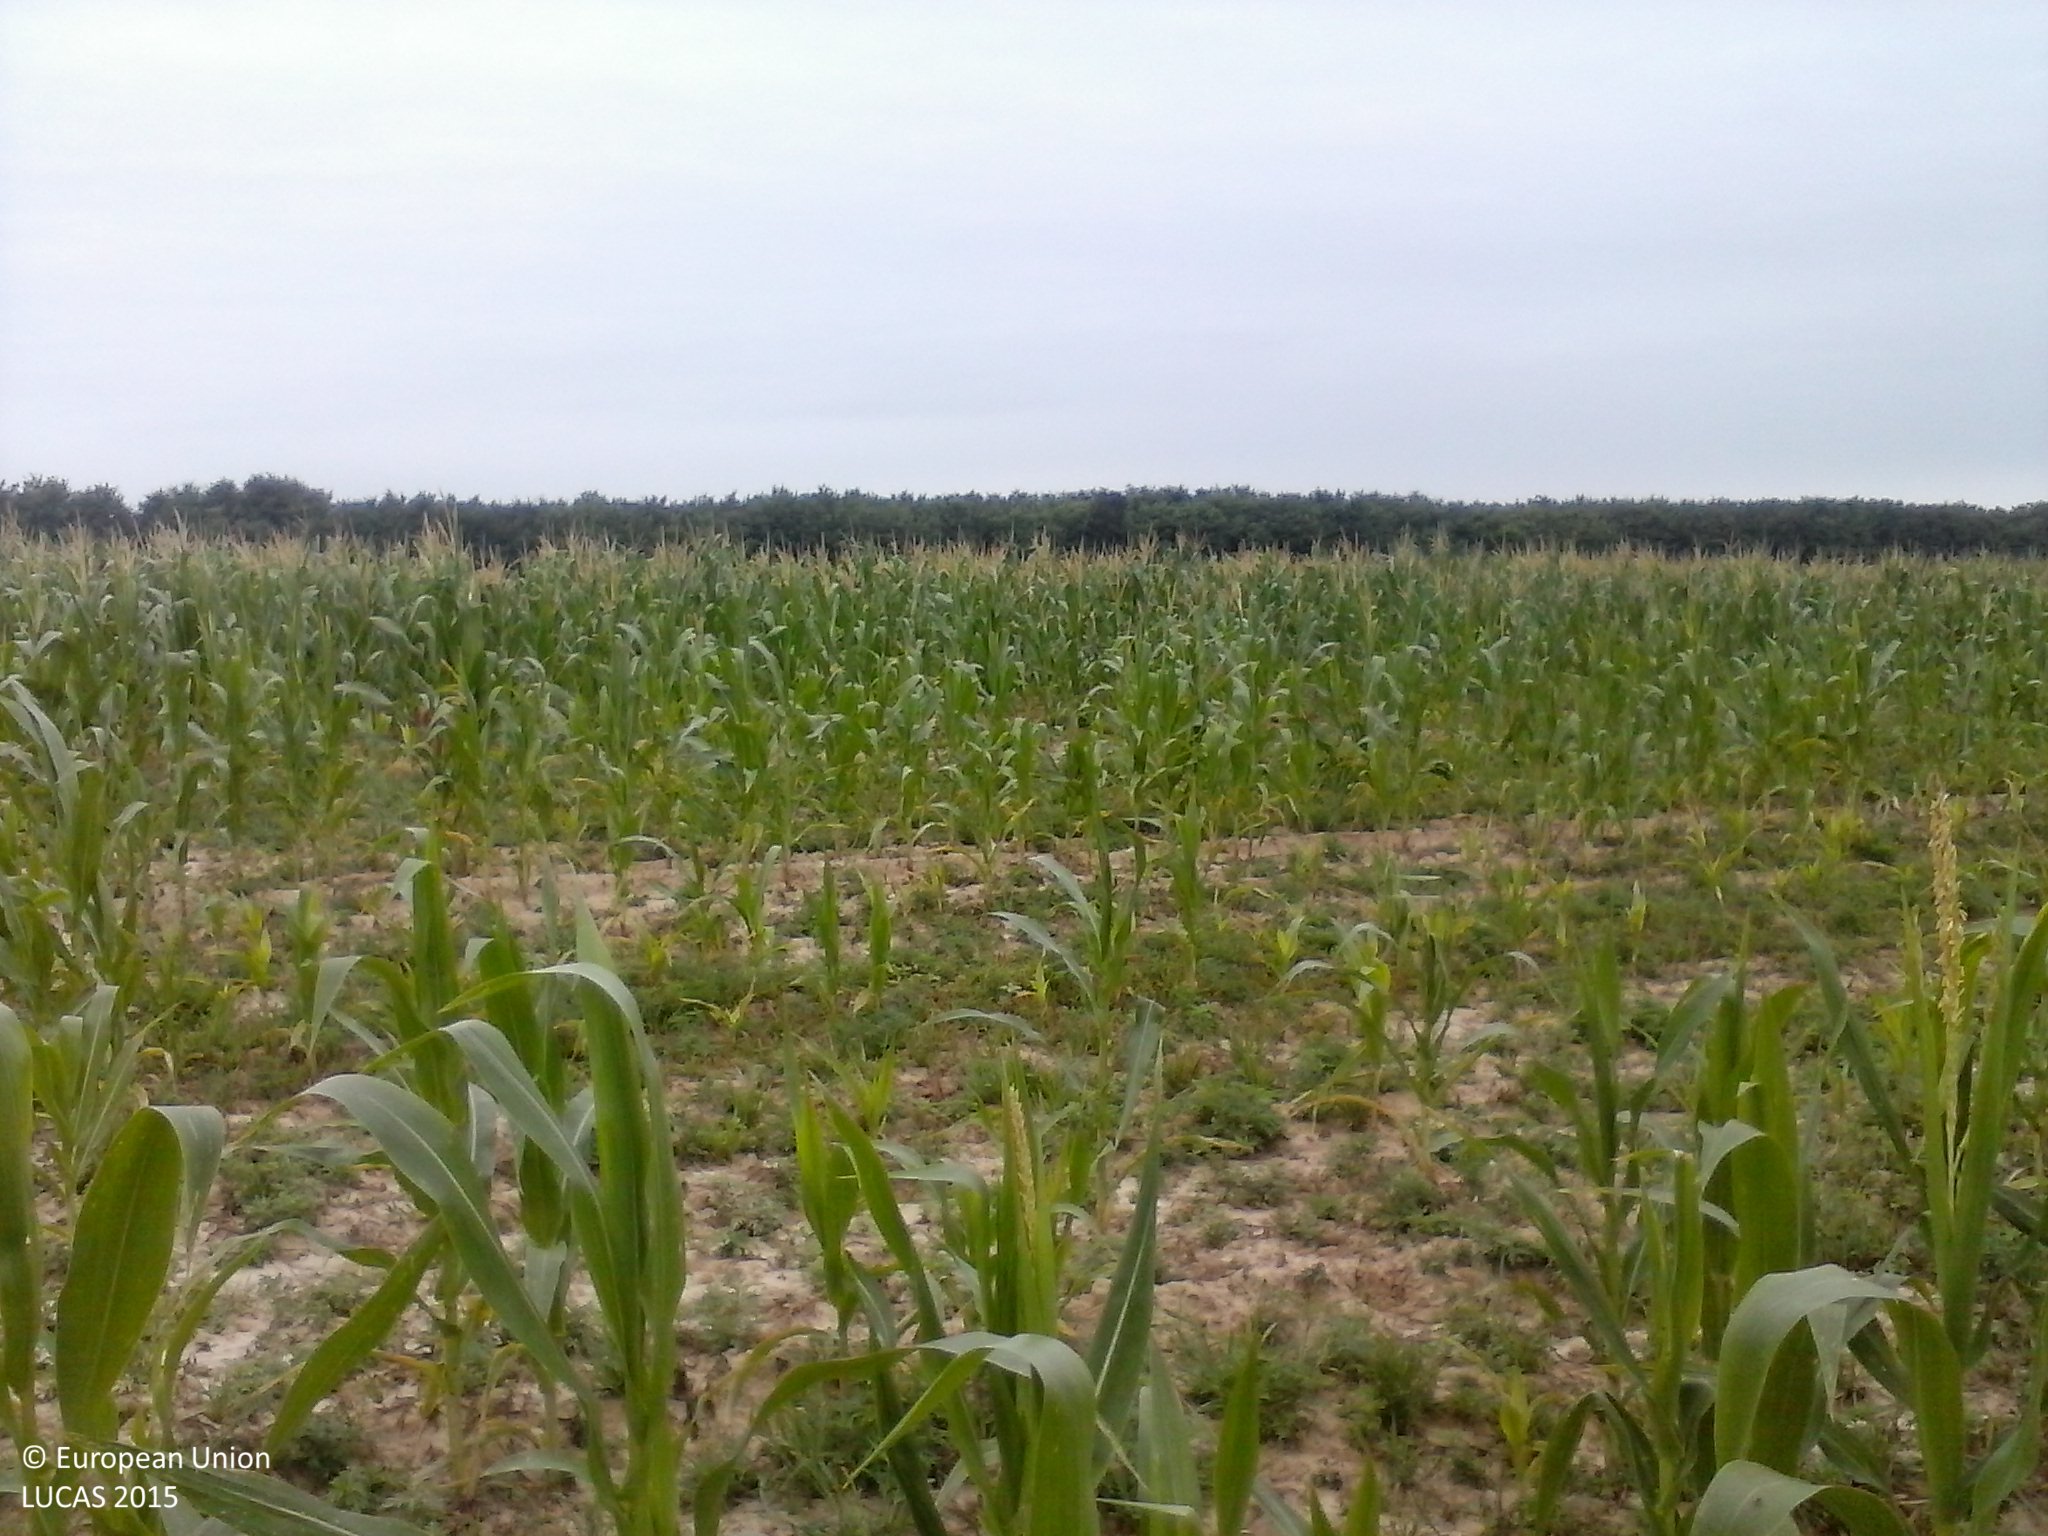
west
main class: Cropland
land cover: Maize
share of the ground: > 75 %
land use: Agriculture (excluding fallow land and kitchen gardens)
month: July
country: HU
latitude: 46.1508
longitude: 17.6305
